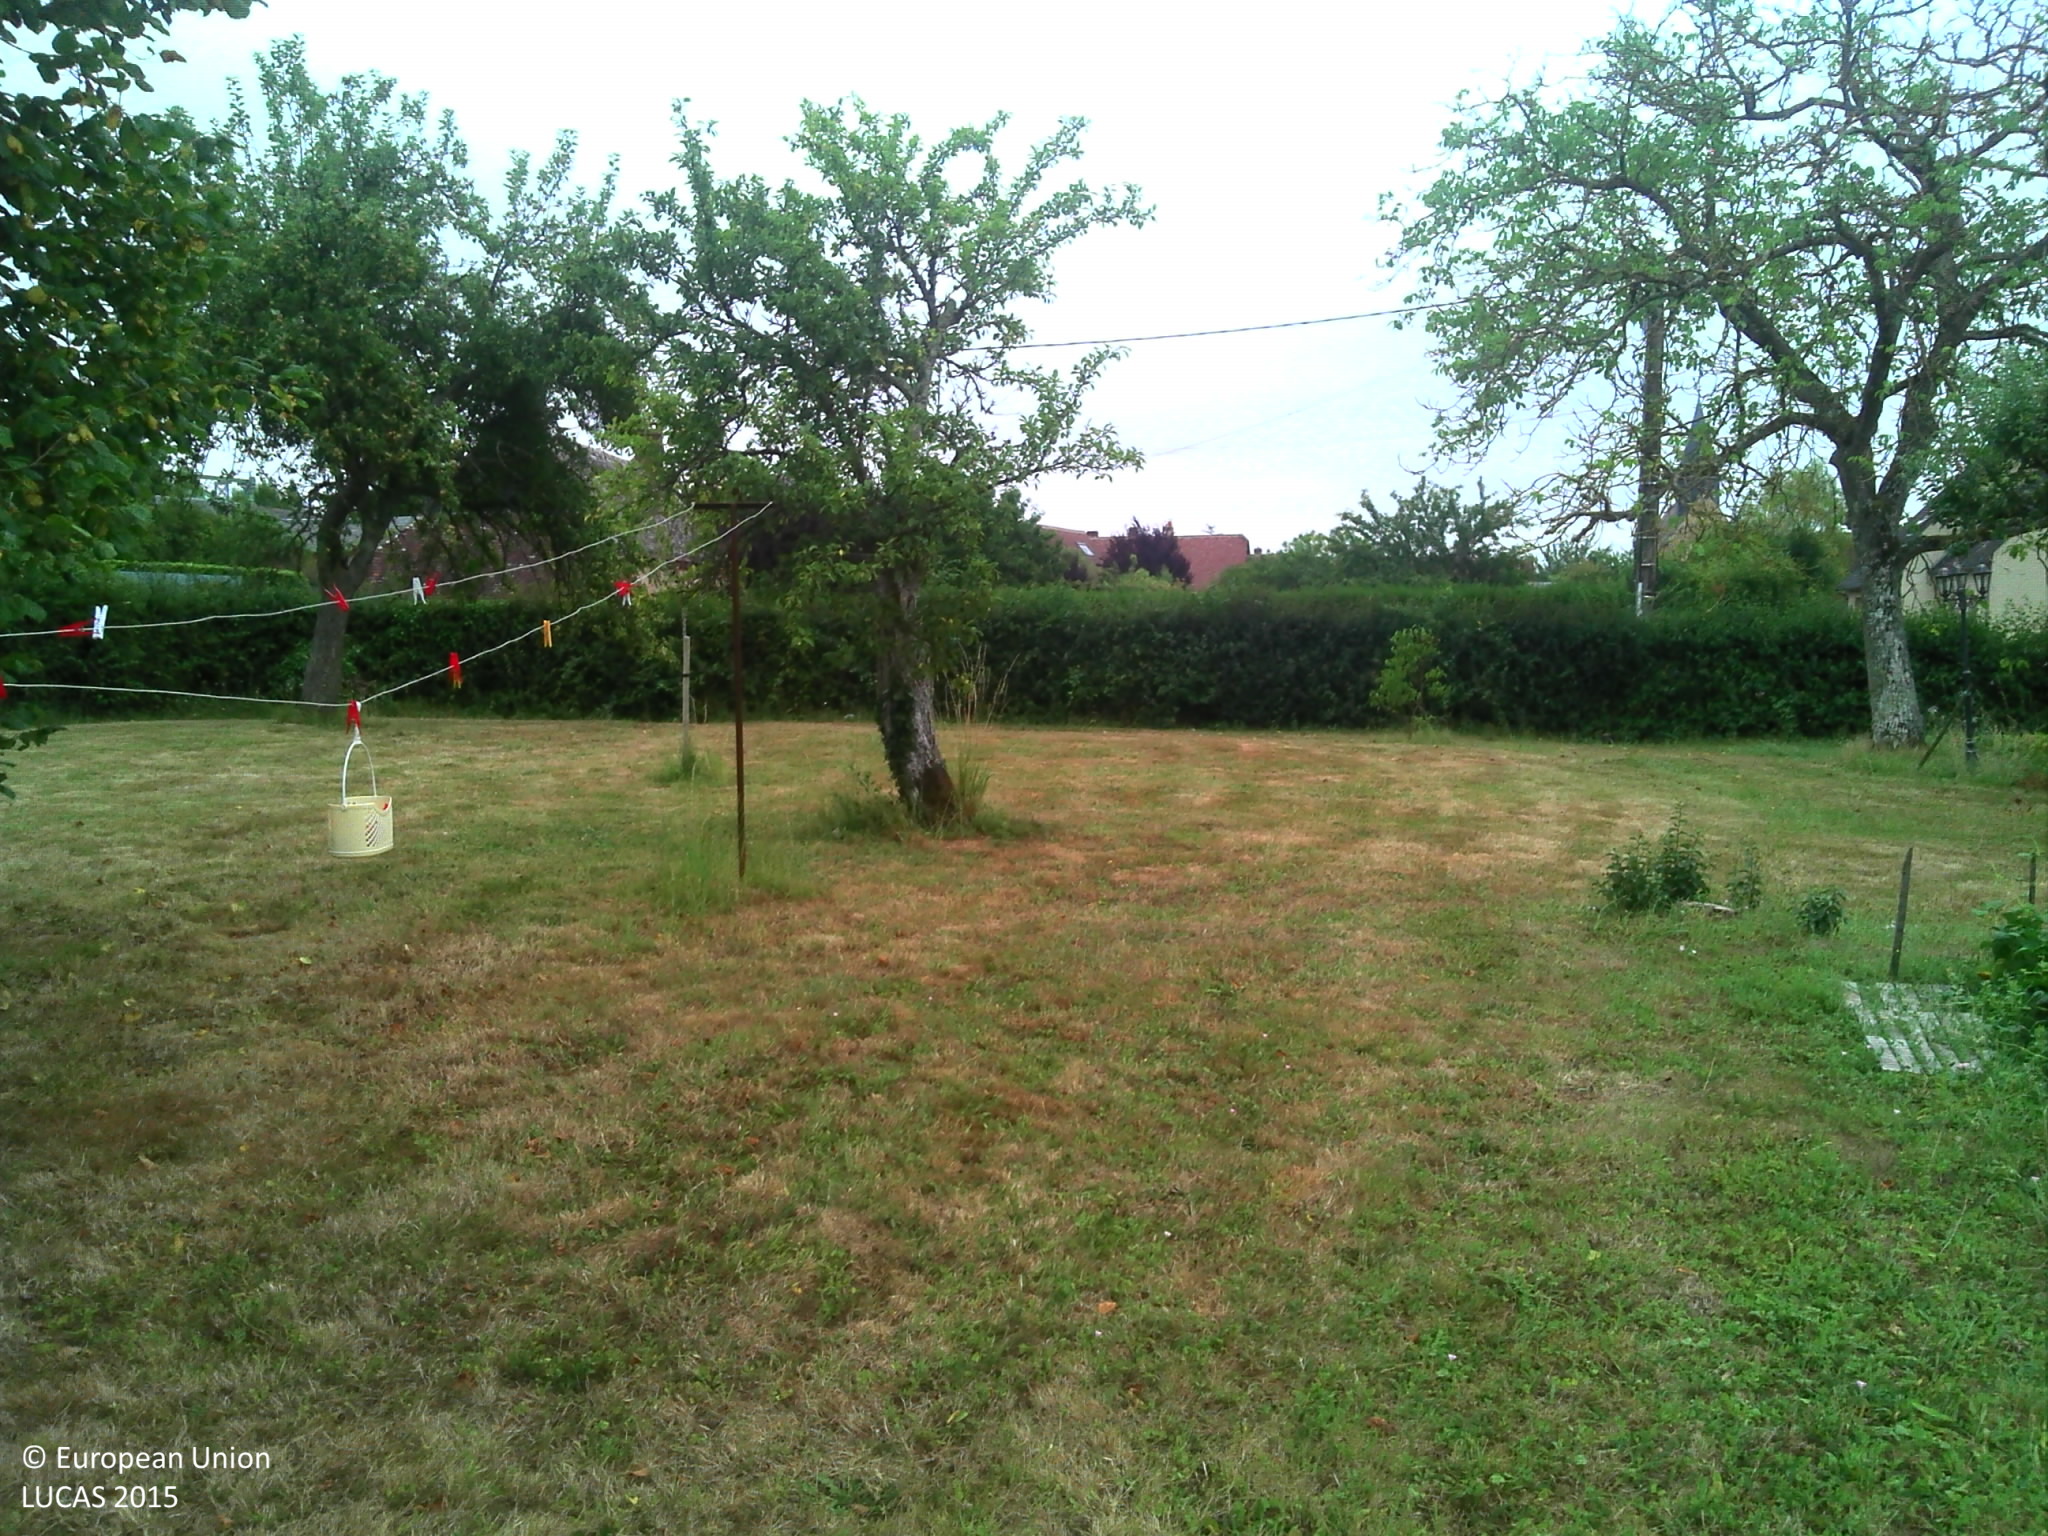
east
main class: Grassland
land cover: Grassland with sparse tree/shrub cover
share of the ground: > 75 %
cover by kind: herbaceous plants 95 %, broadleaved forest trees 5 %
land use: Residential
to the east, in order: Grassland with sparse tree/shrub cover; Artificial constructions in urban areas; Grassland with sparse tree/shrub cover
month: July
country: FR
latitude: 48.2750
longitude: 1.0470
